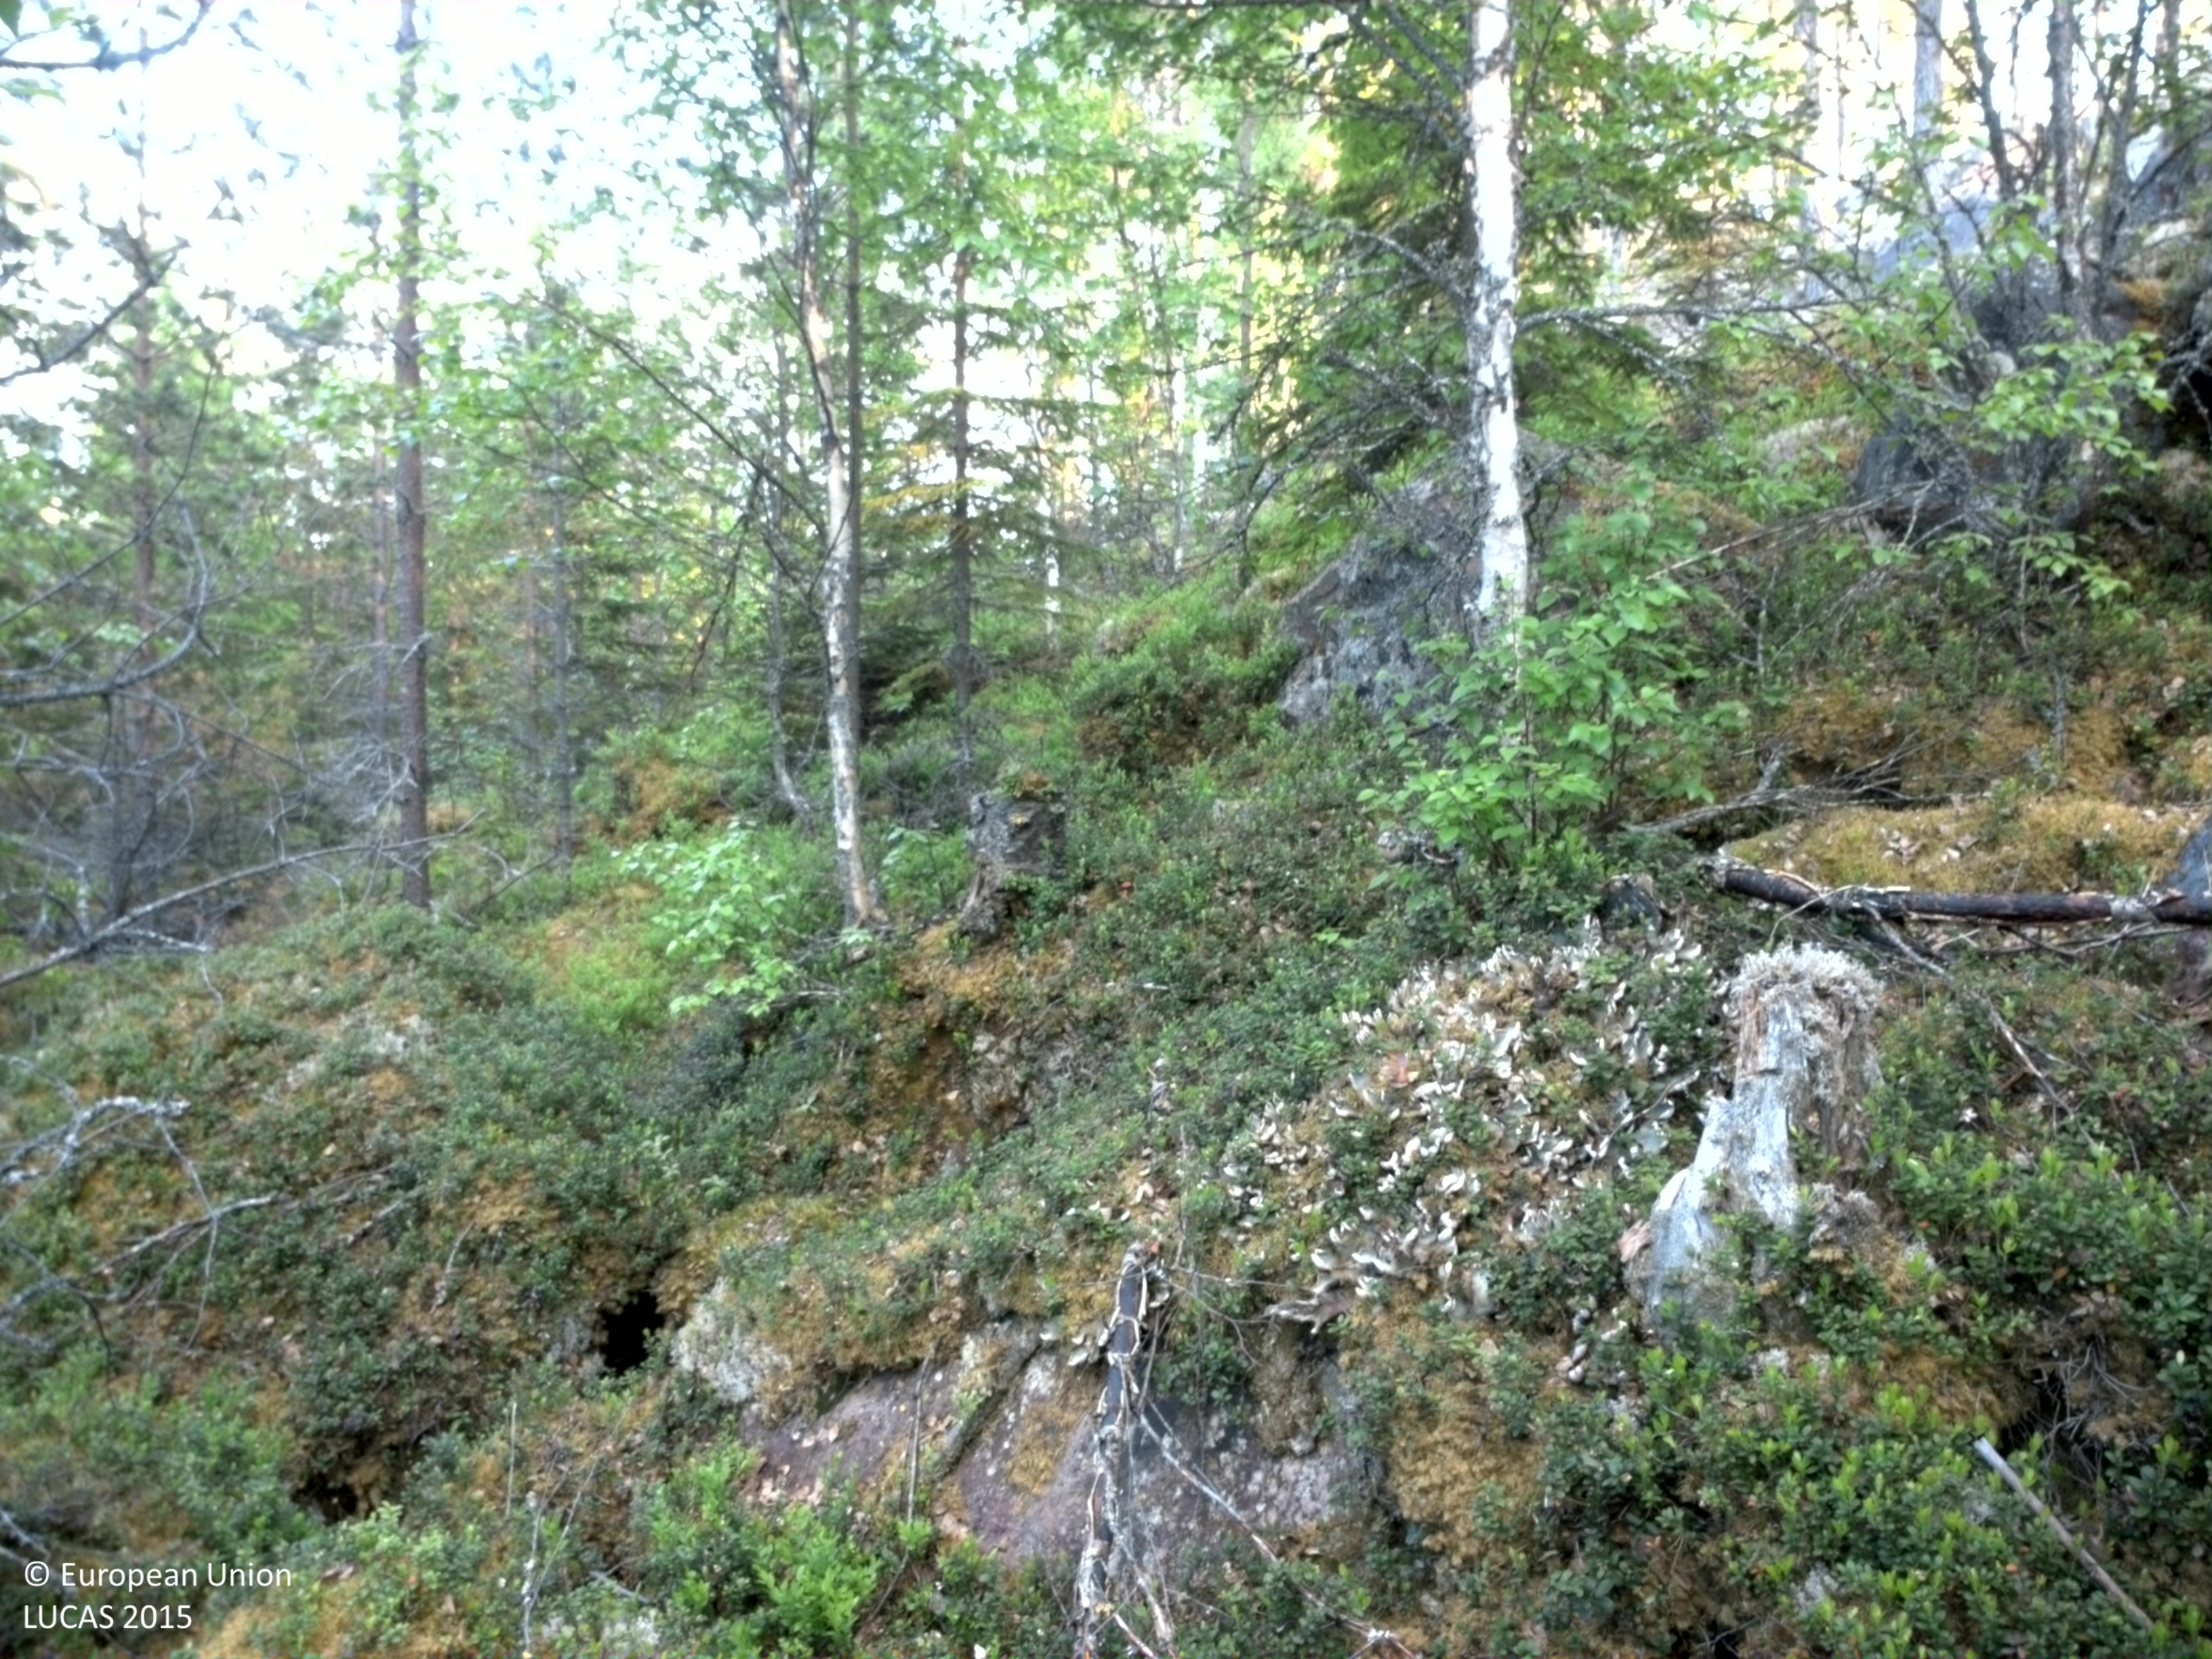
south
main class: Woodland
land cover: Other mixed woodland
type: boreal forest
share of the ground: 50 - 75 %
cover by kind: coniferous forest trees 30 %, shrubs 25 %, lichens and mosses 25 %, broadleaved forest trees 10 %, herbaceous plants 10 %
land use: Forestry
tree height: > 5 m
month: June
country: SE
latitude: 61.0891
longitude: 13.6409
